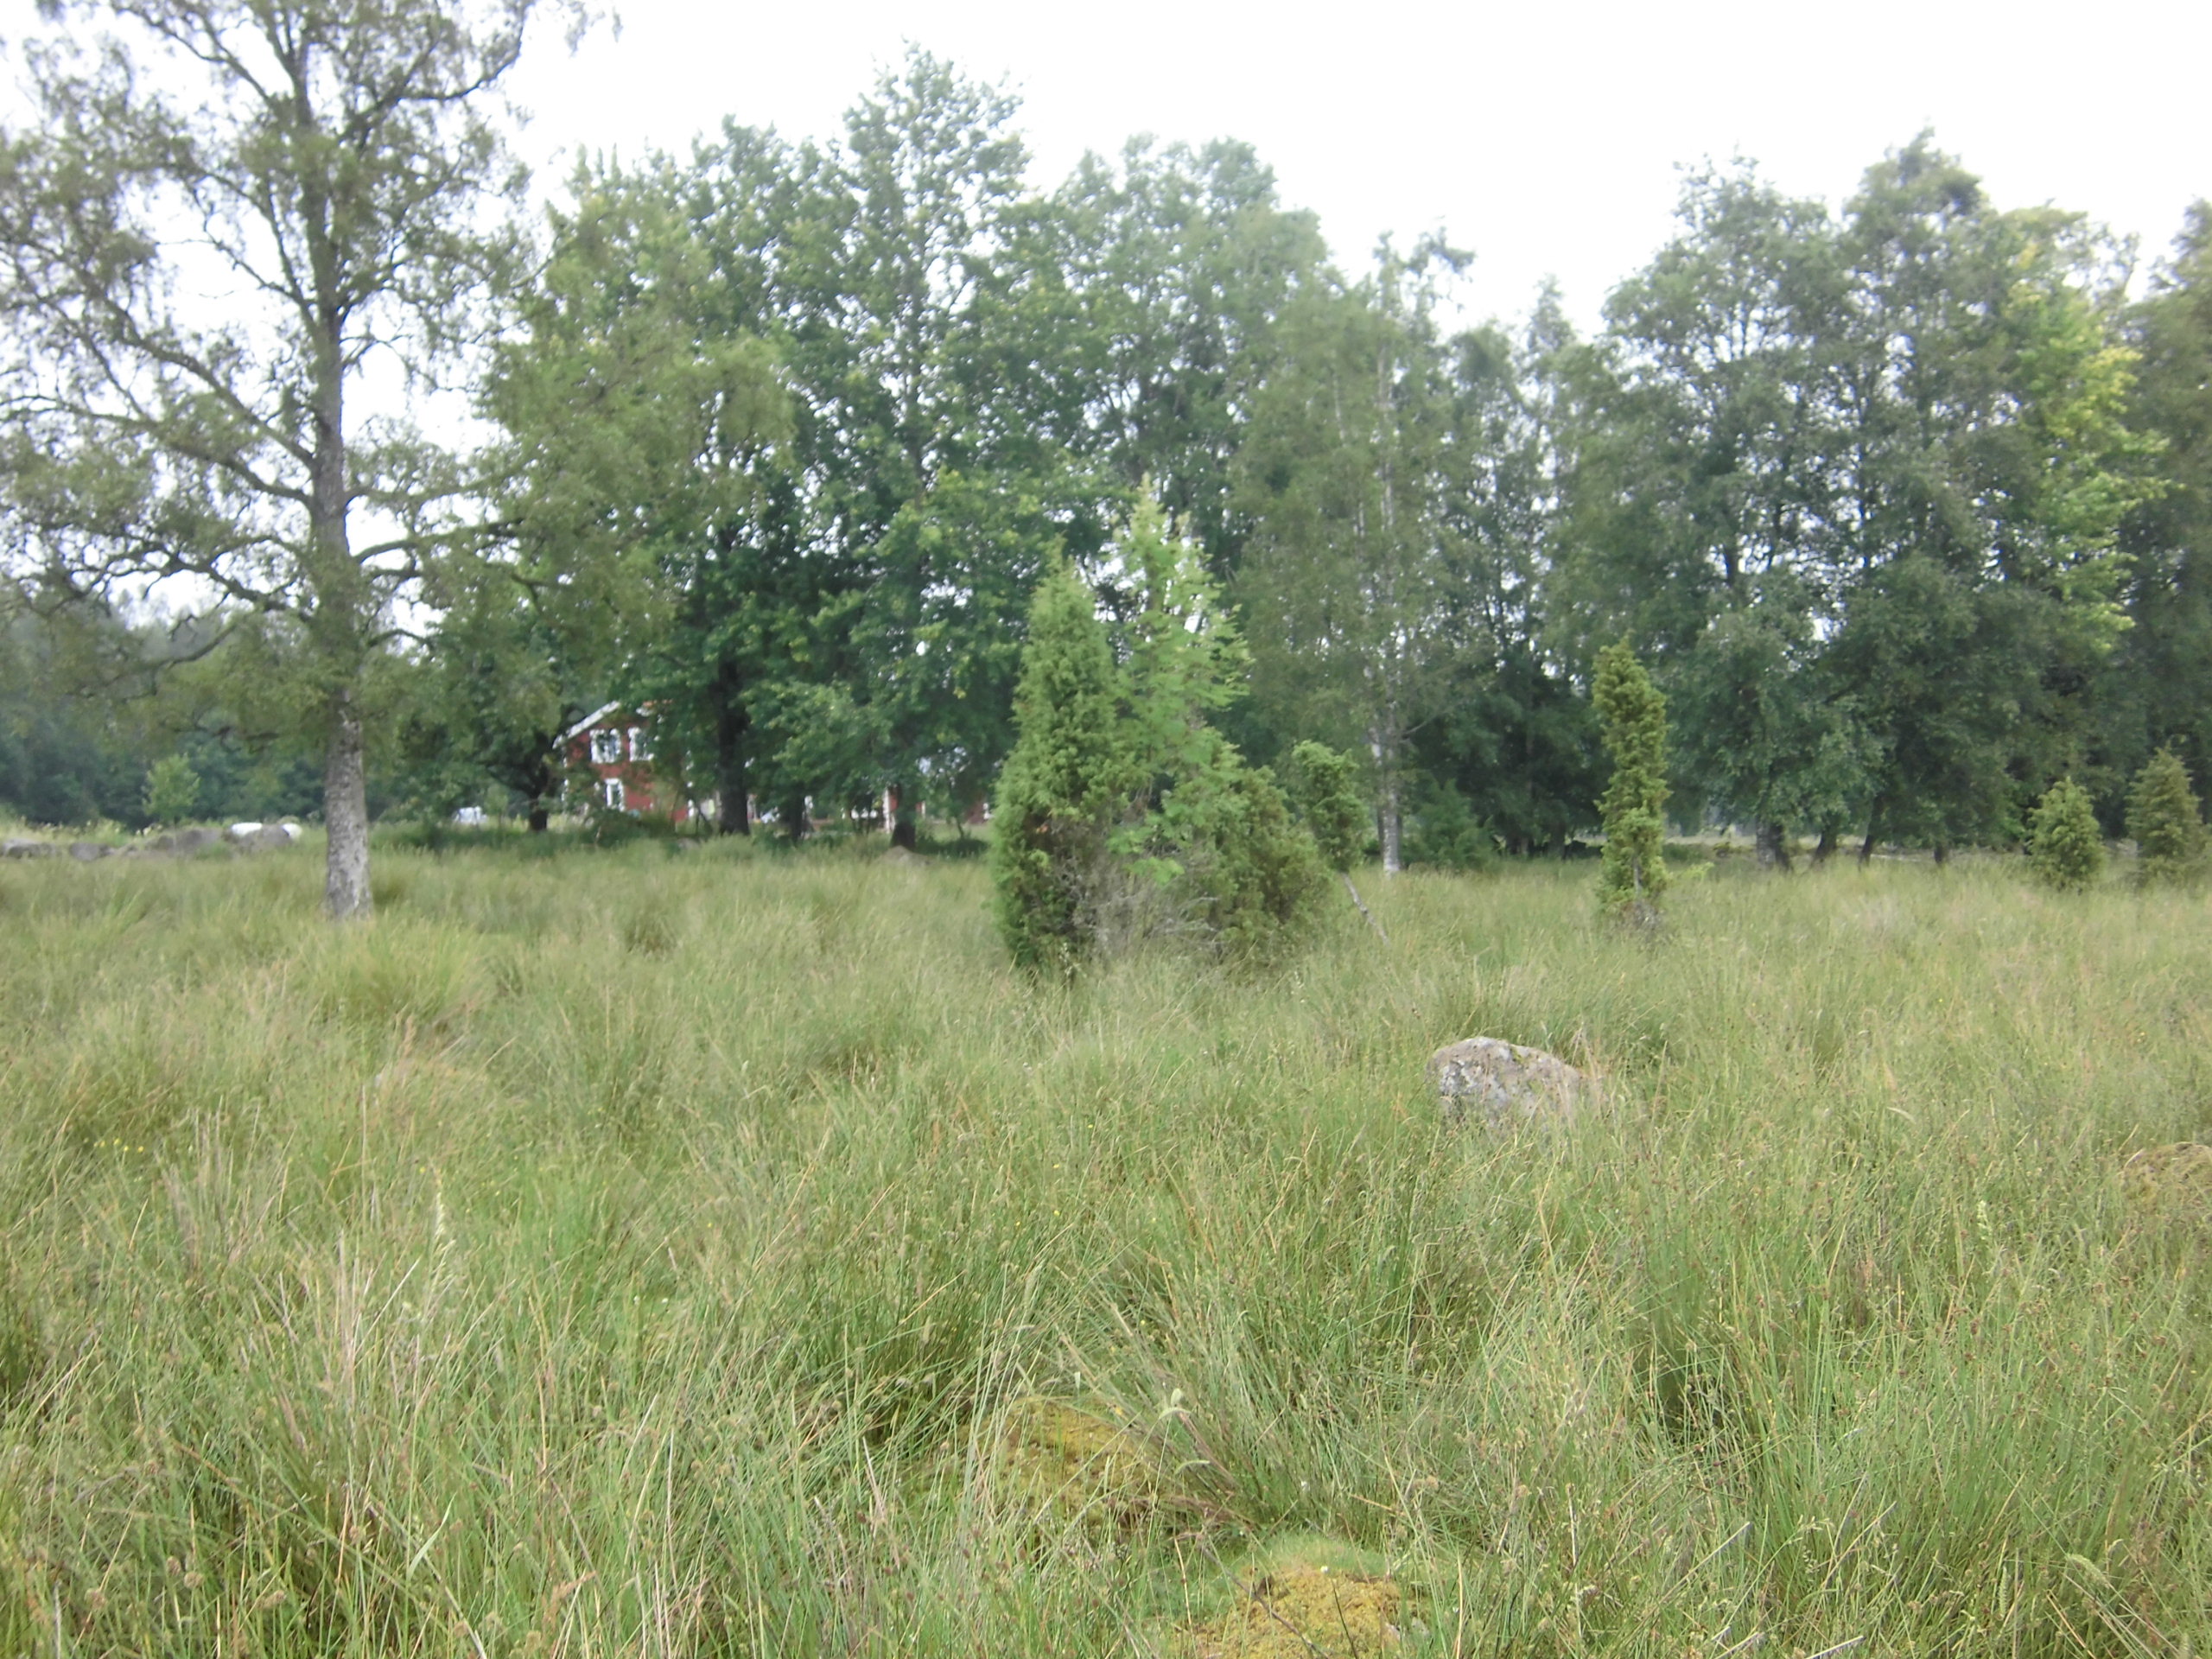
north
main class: Grassland
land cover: Grassland without tree/shrub cover
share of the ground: > 75 %
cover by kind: herbaceous plants 100 %
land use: Agriculture (excluding fallow land and kitchen gardens)
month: July
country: SE
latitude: 57.3219
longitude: 14.8287
